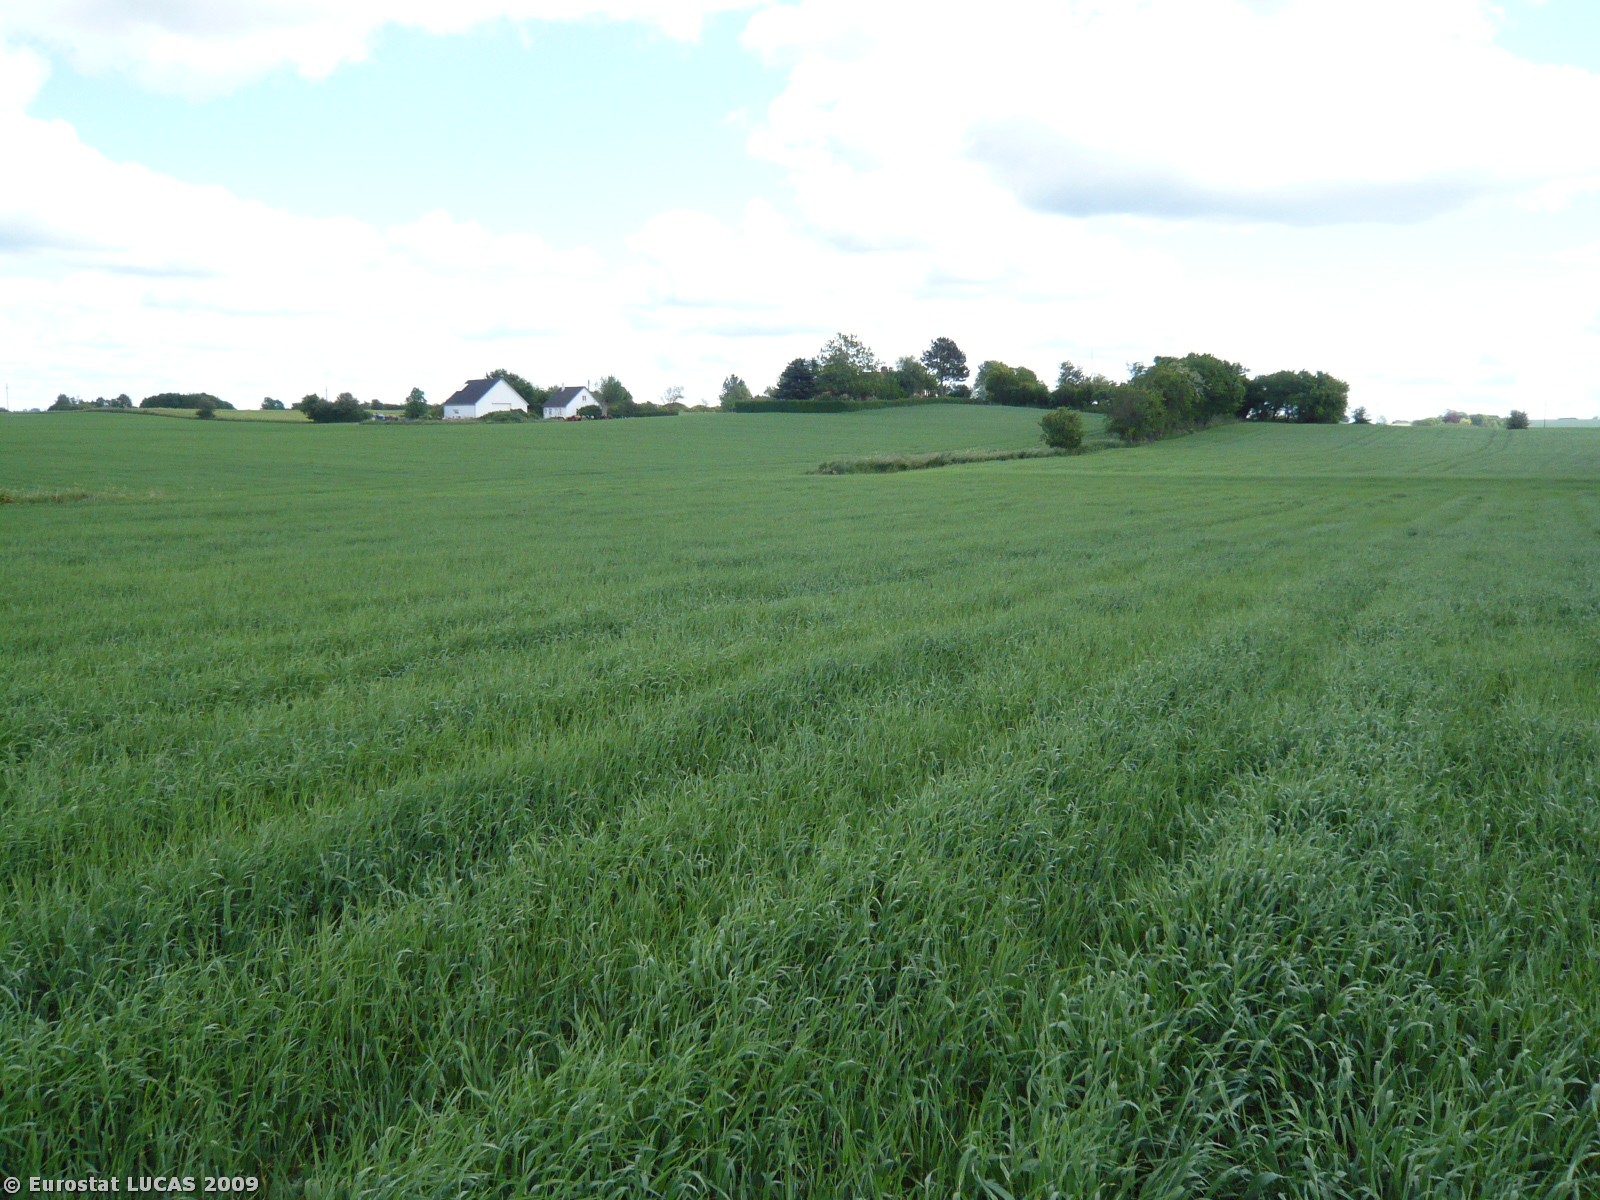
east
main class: Cropland
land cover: Barley
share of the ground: > 75 %
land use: Agriculture (excluding fallow land and kitchen gardens)
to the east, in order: Barley; Grass margins; Barley; Managed hedges; Artificial constructions in urban areas; Paved roads, cycling and walking lanes; Grass margins; Barley
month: June
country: DK
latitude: 55.2255
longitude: 11.5552
